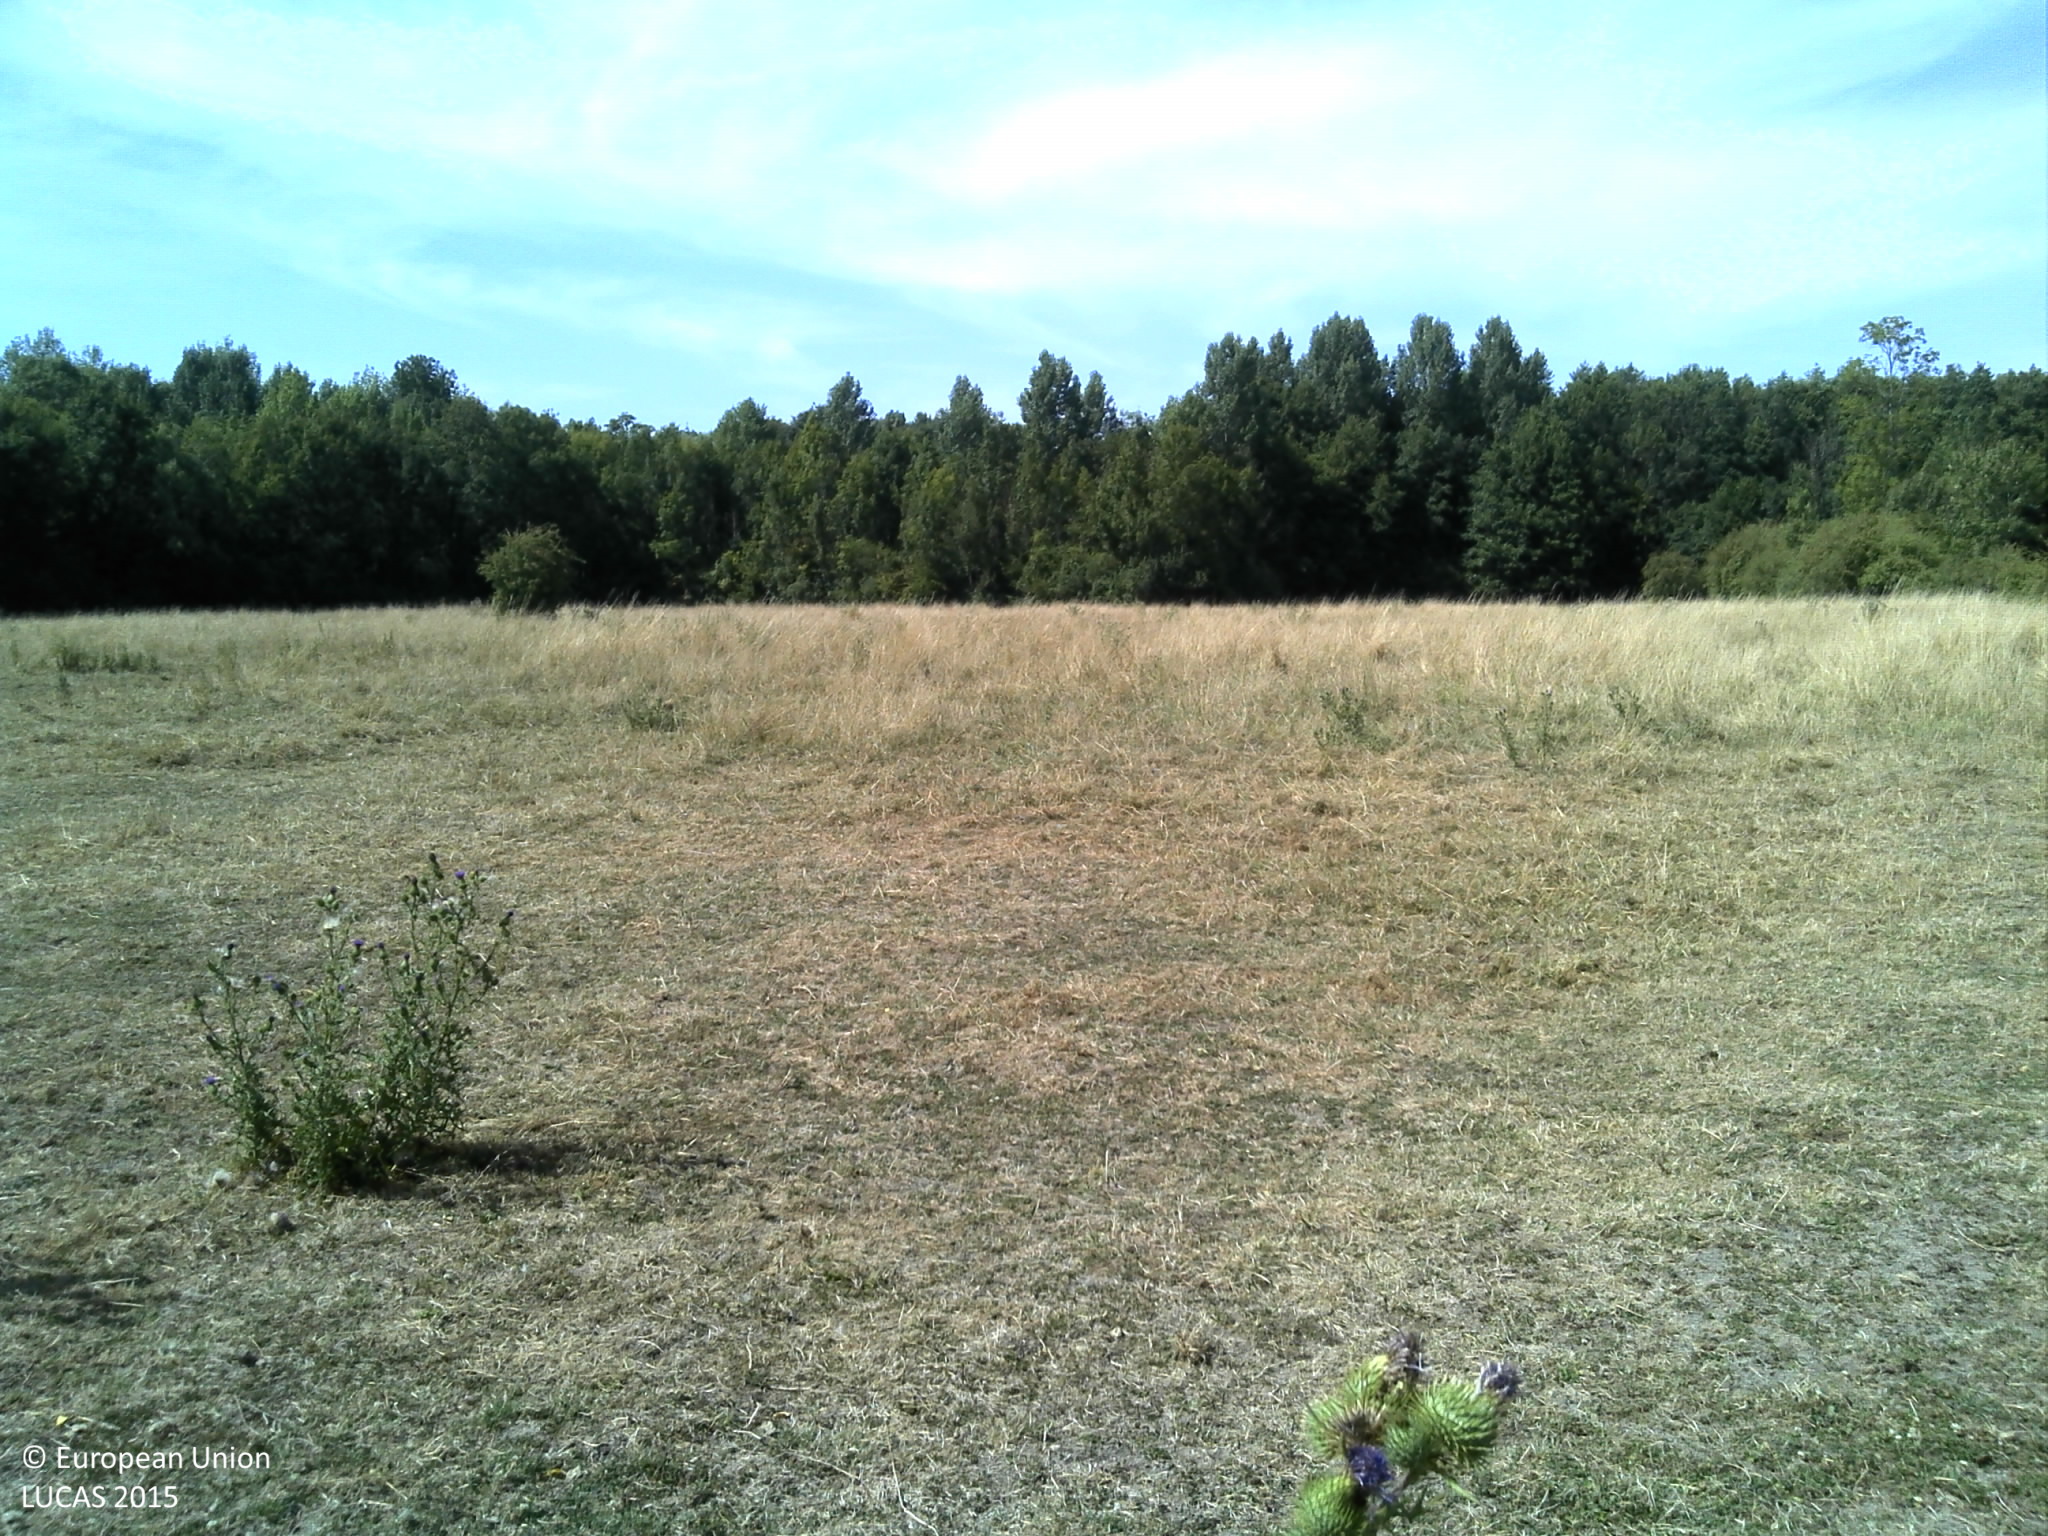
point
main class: Grassland
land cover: Grassland without tree/shrub cover
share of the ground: > 75 %
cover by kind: herbaceous plants 90 %, shrubs 5 %, consolidated bare surface 5 %
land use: Agriculture (excluding fallow land and kitchen gardens)
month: August
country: FR
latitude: 49.1812
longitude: 4.7703
